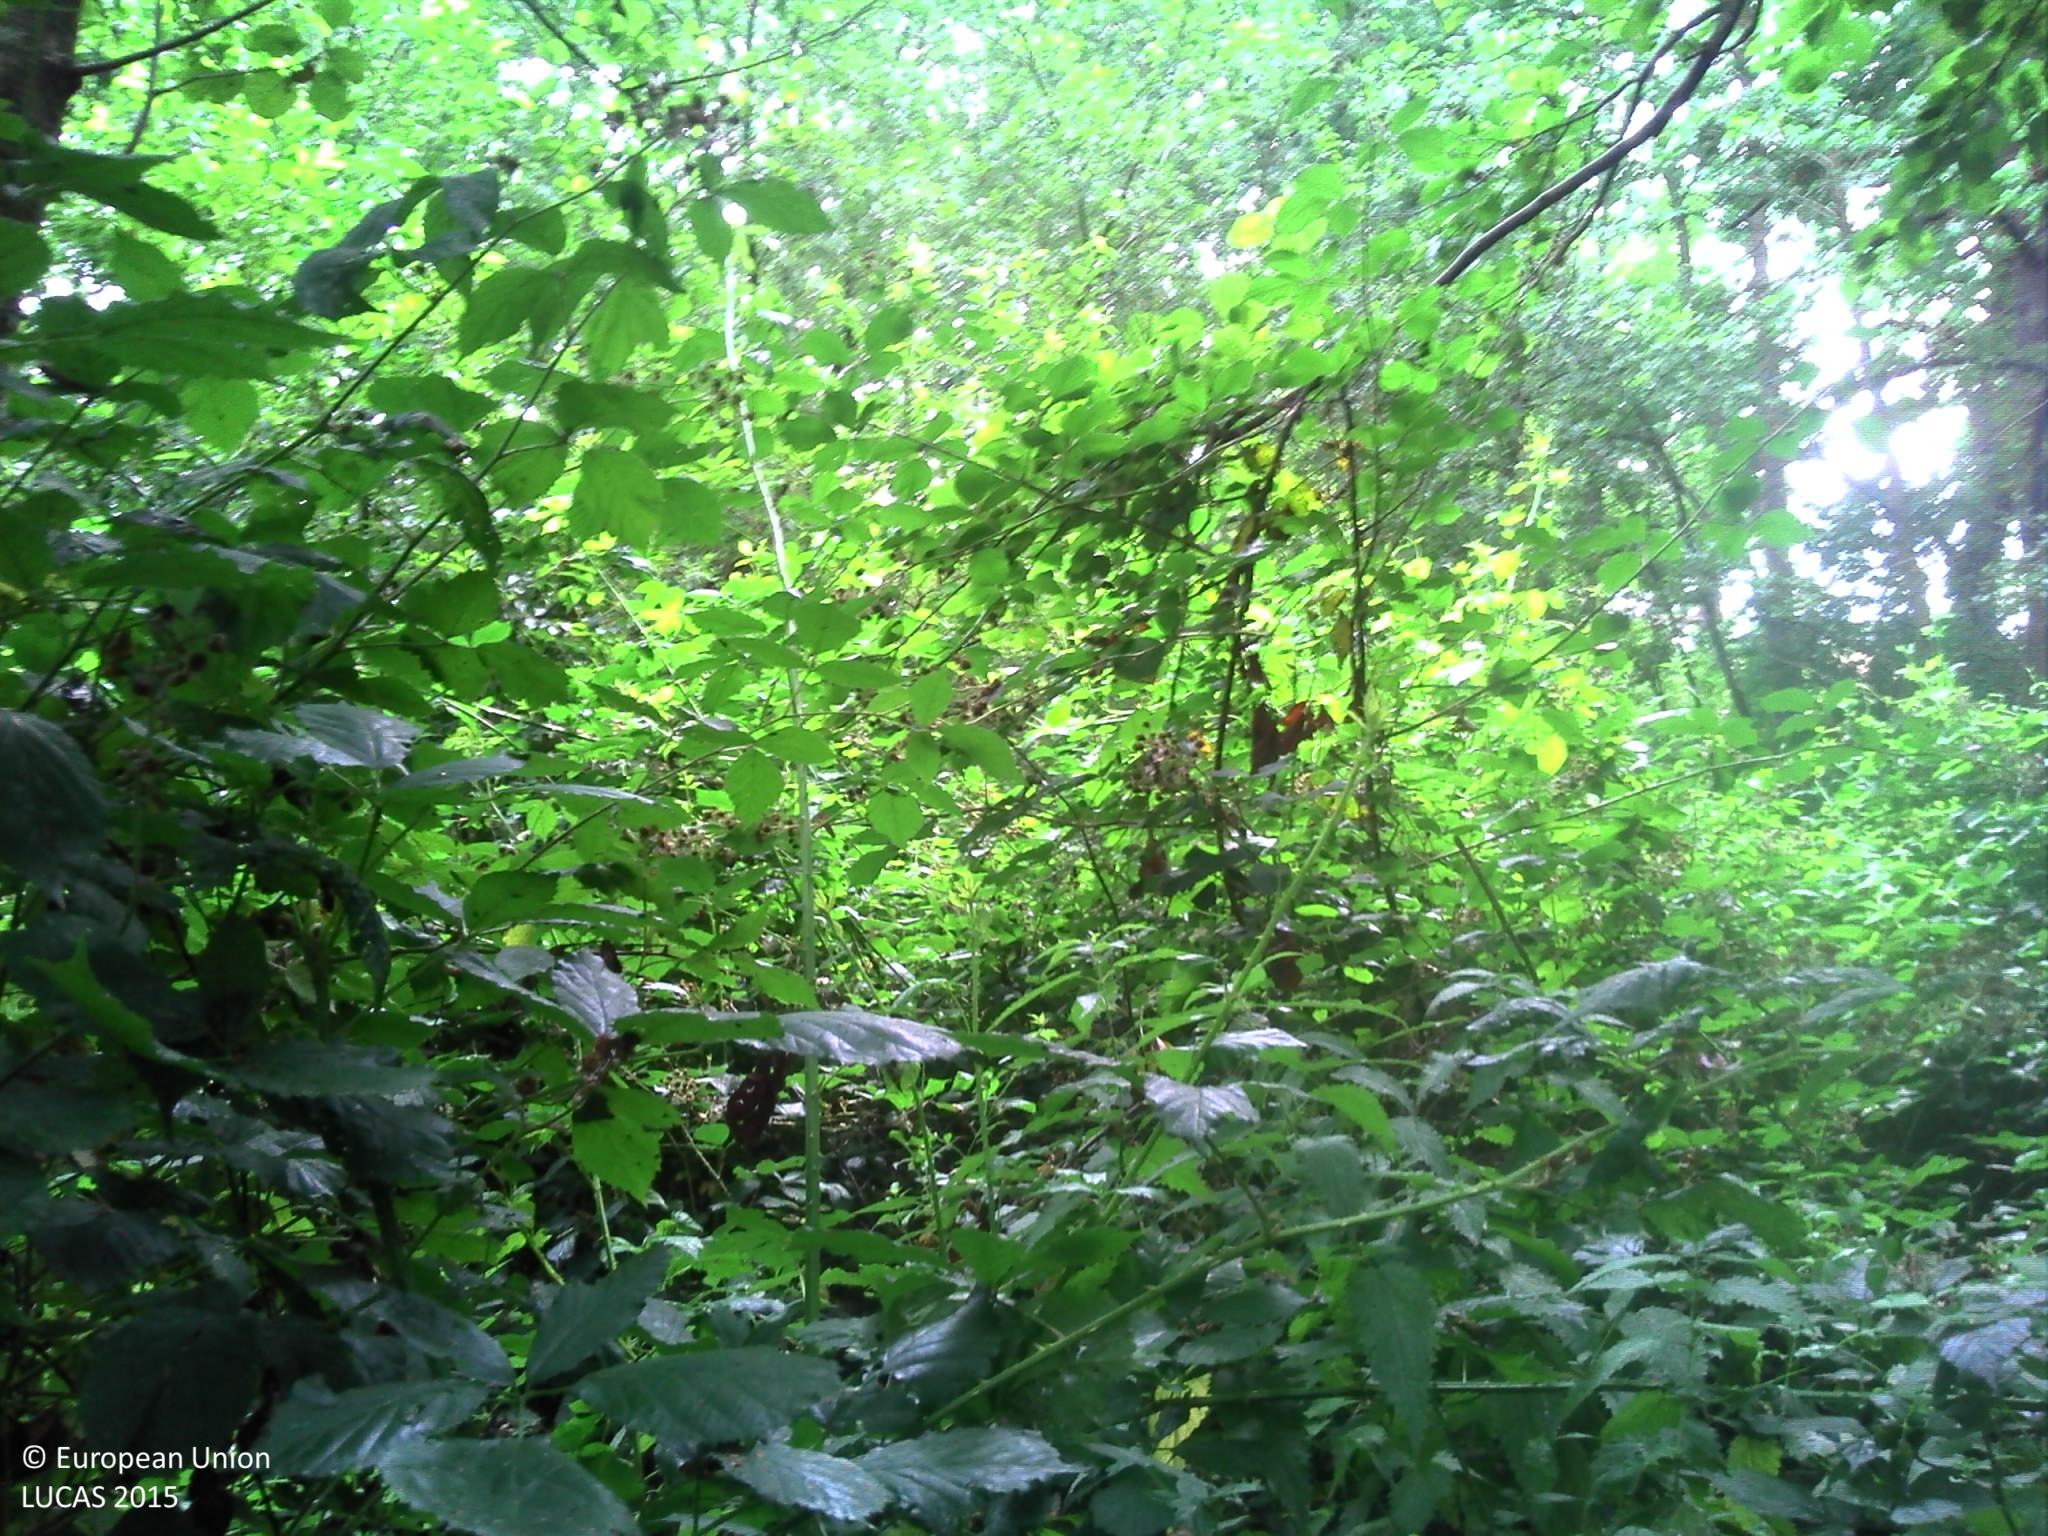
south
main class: Woodland
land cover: Broadleaved woodland
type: floodplain forest
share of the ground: > 75 %
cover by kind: broadleaved forest trees 90 %, shrubs 10 %
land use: Semi-natural and natural areas not in use
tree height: > 5 m
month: July
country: FR
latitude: 48.7272
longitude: -1.5081
